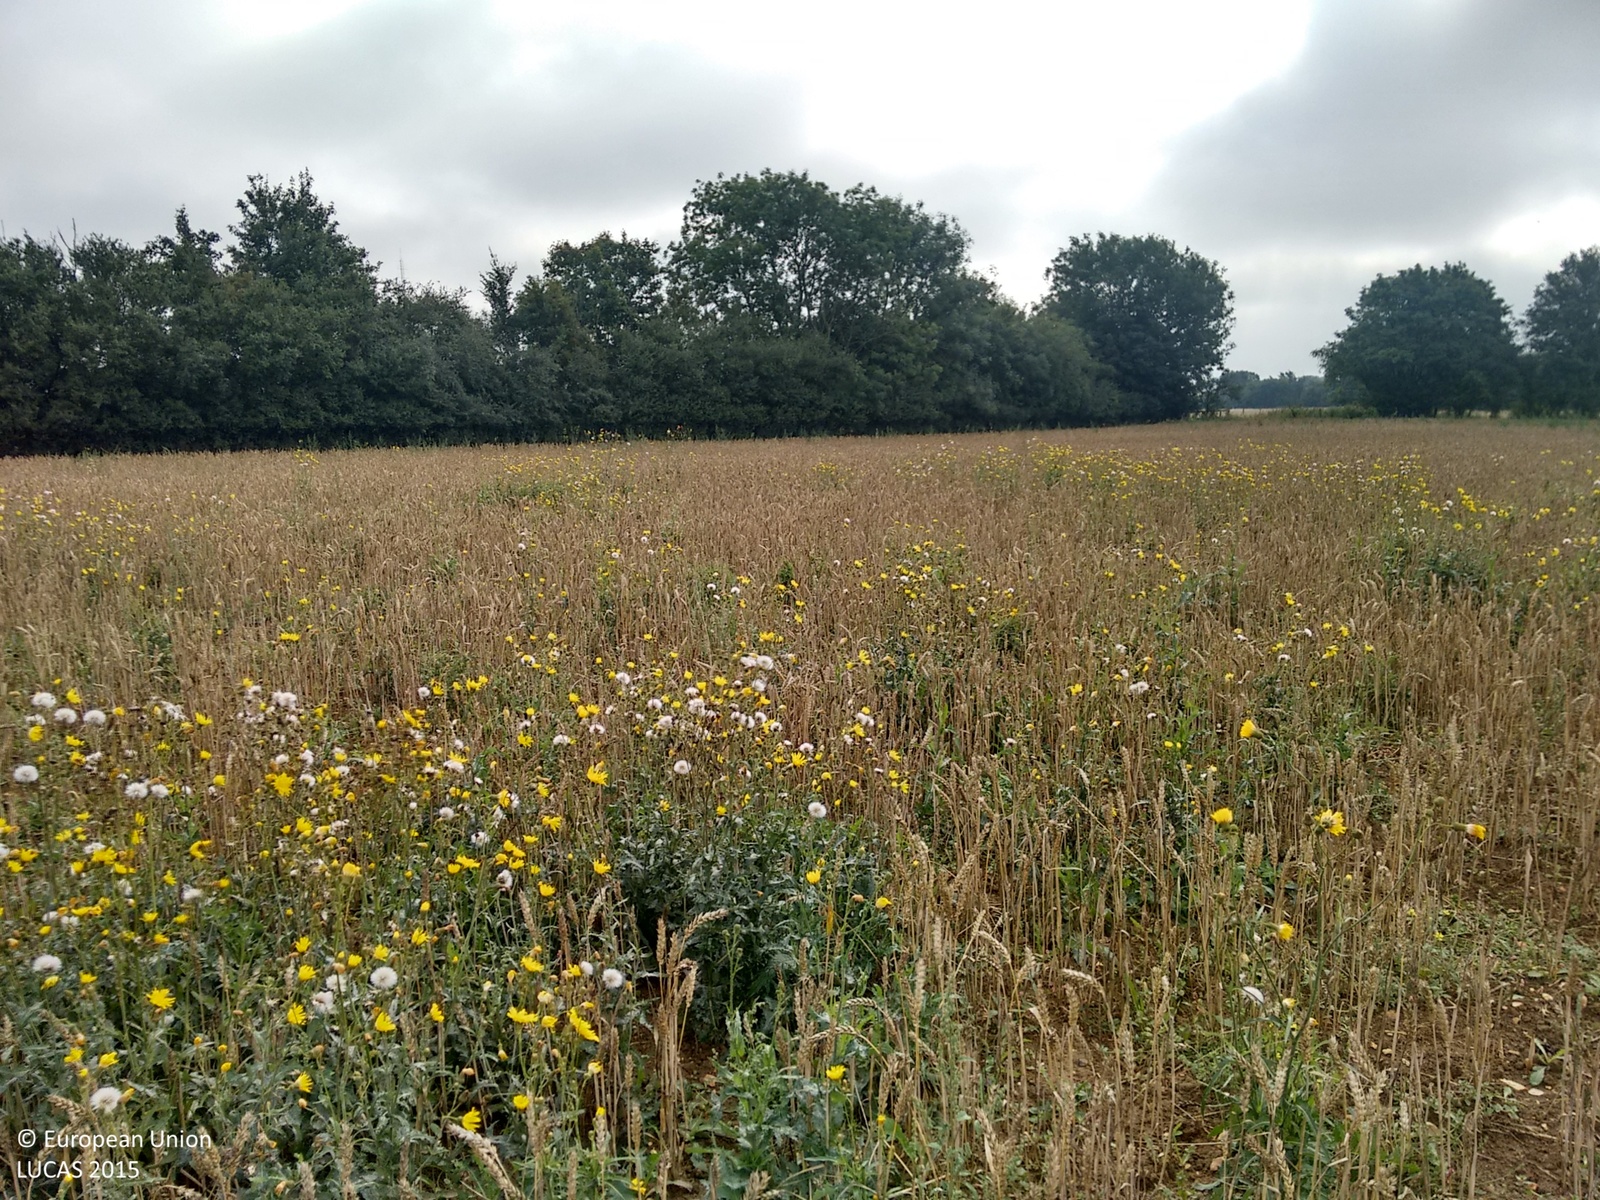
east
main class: Cropland
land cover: Common wheat
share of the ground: > 75 %
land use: Agriculture (excluding fallow land and kitchen gardens)
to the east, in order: Common wheat; Abandoned hedges; Ditches and canals; Abandoned hedges; Fences; Grassland without tree/shrub cover; Fences; Abandoned hedges; Grassland without tree/shrub cover; Fences; Grassland without tree/shrub cover
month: September
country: GB
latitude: 52.2001
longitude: 0.5650
